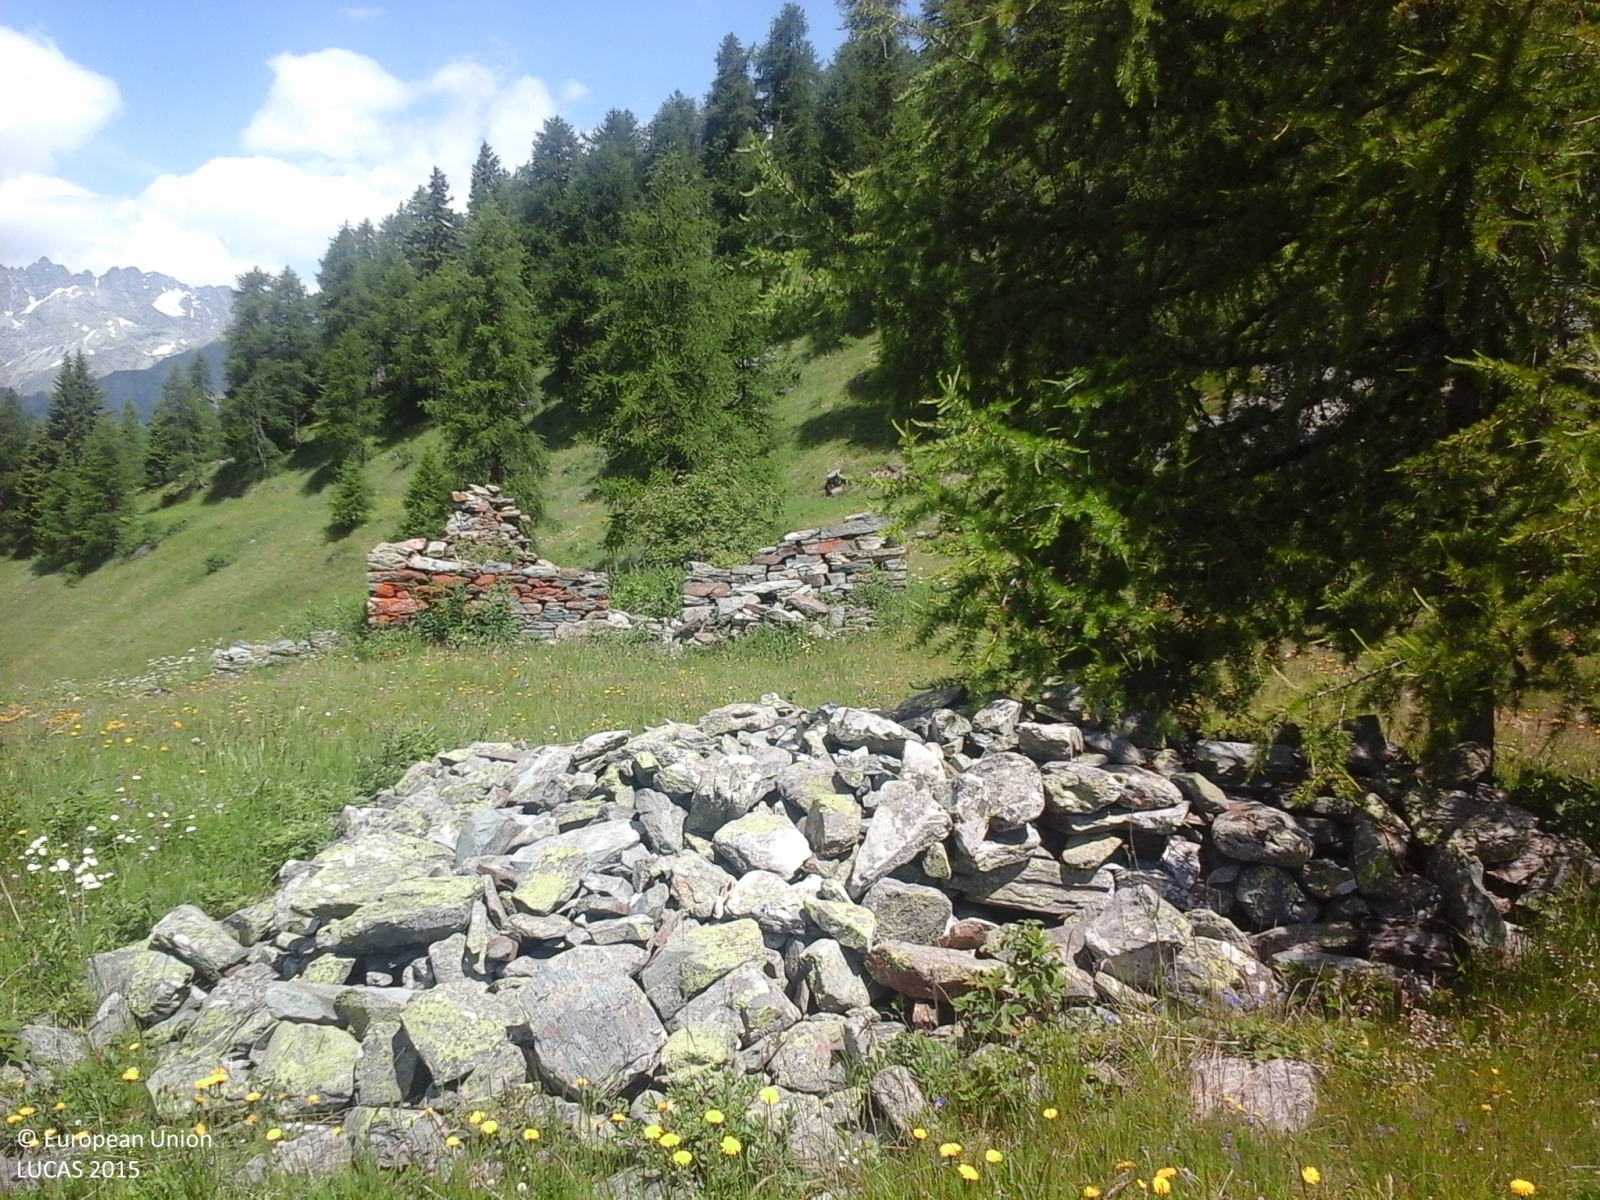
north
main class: Grassland
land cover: Grassland with sparse tree/shrub cover
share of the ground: > 75 %
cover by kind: herbaceous plants 90 %, coniferous forest trees 5 %
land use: Agriculture (excluding fallow land and kitchen gardens)
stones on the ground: < 10 %
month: June
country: IT
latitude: 45.8202
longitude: 7.6222
